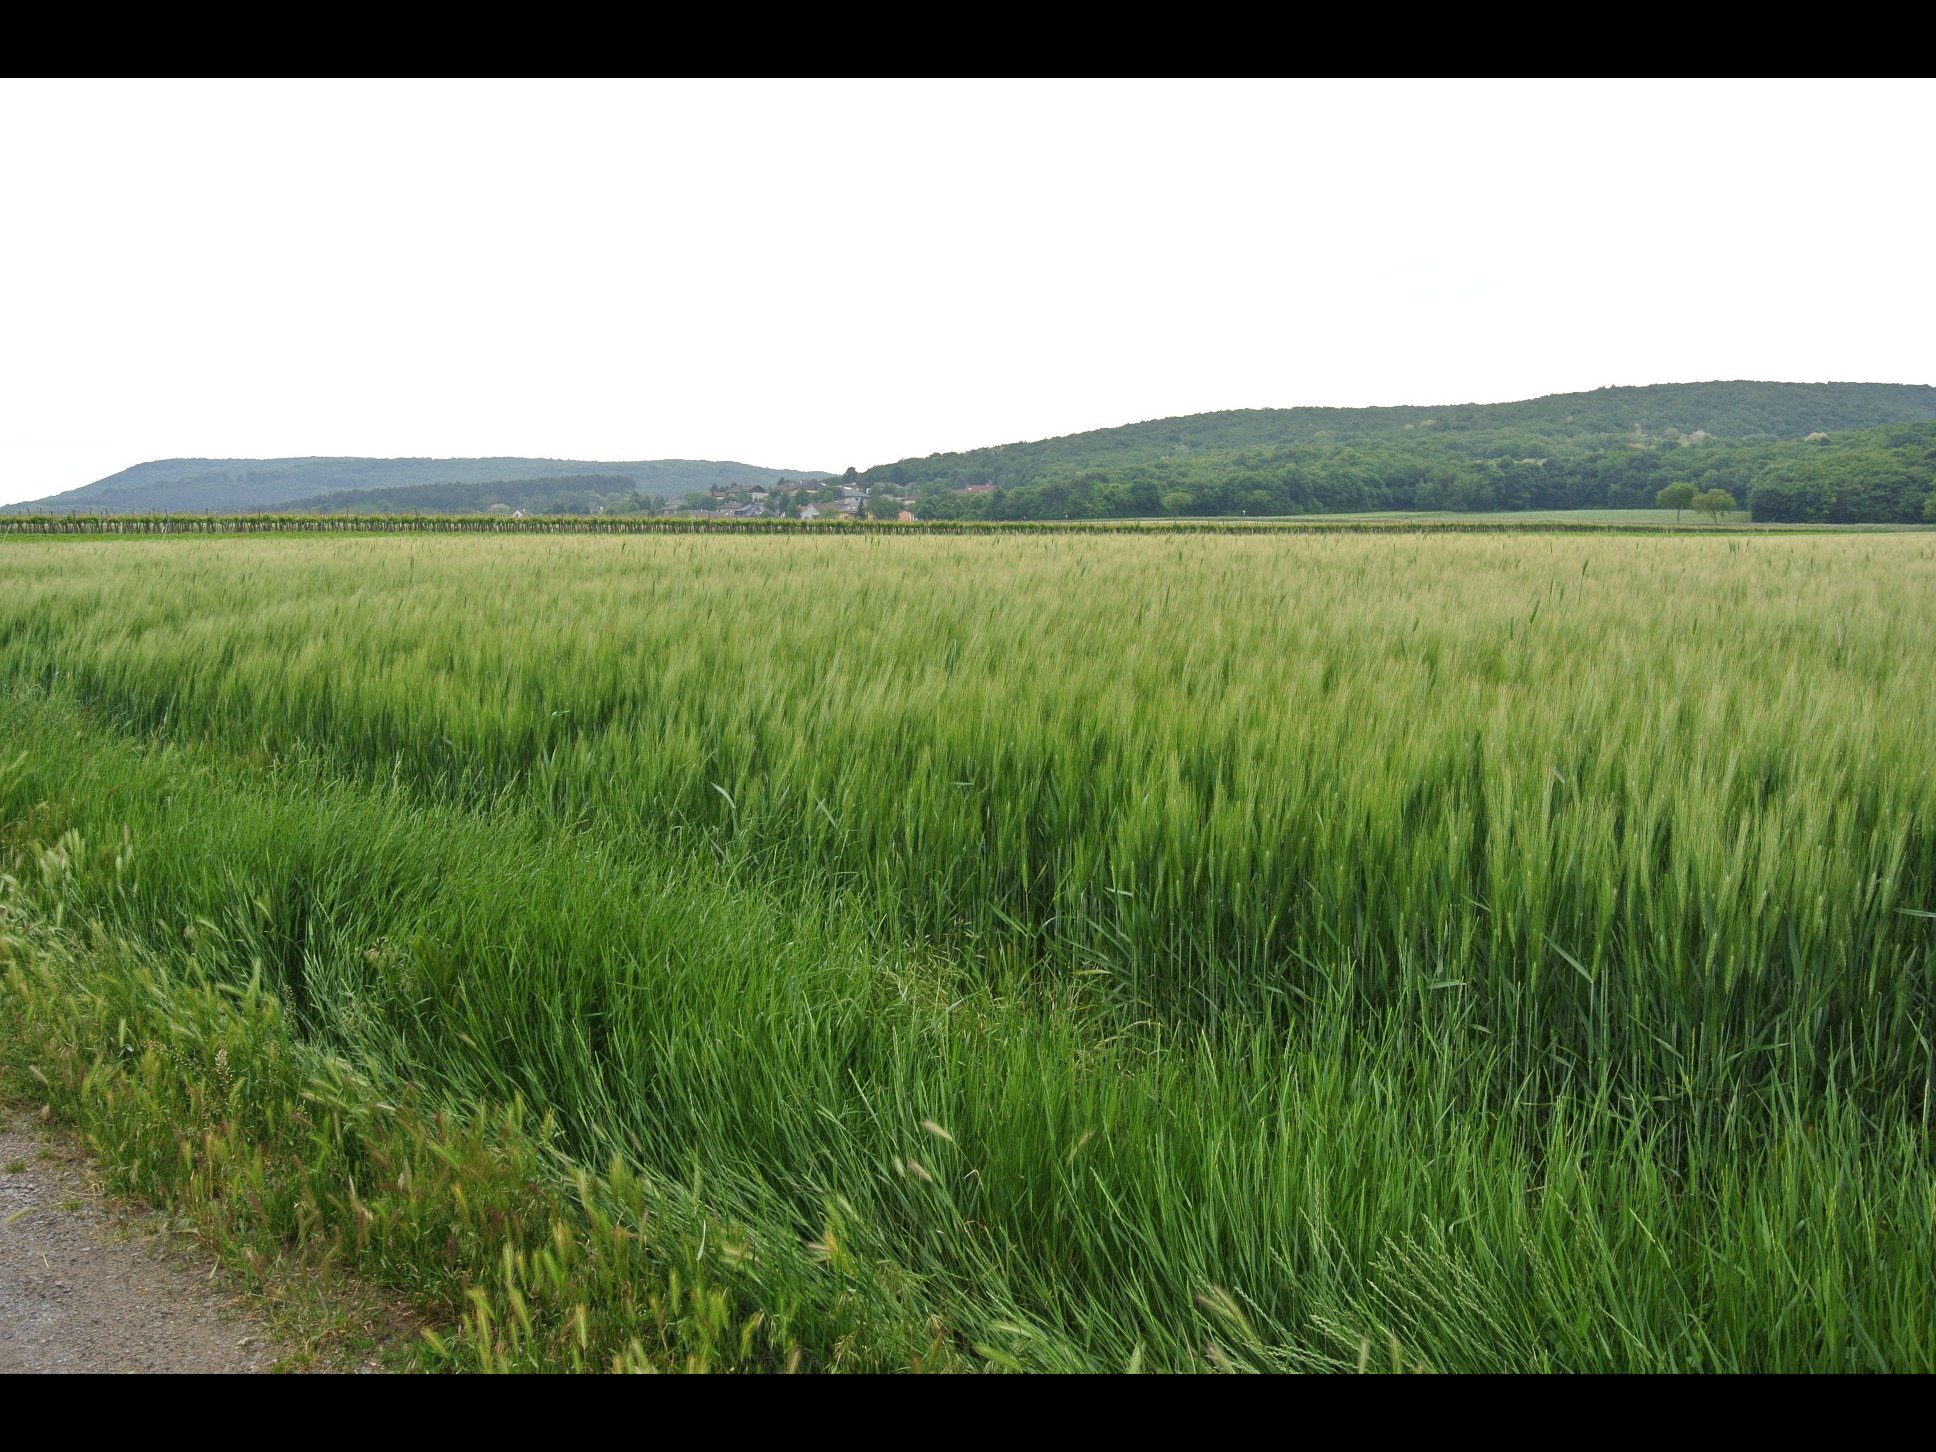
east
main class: Cropland
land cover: Durum wheat
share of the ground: > 75 %
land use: Agriculture (excluding fallow land and kitchen gardens)
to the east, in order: Durum wheat; Tracks; Barley; Vineyards; Barley; Grass margins; Tracks; Grass margins; Barley
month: May
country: AT
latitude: 47.9873
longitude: 16.6382
